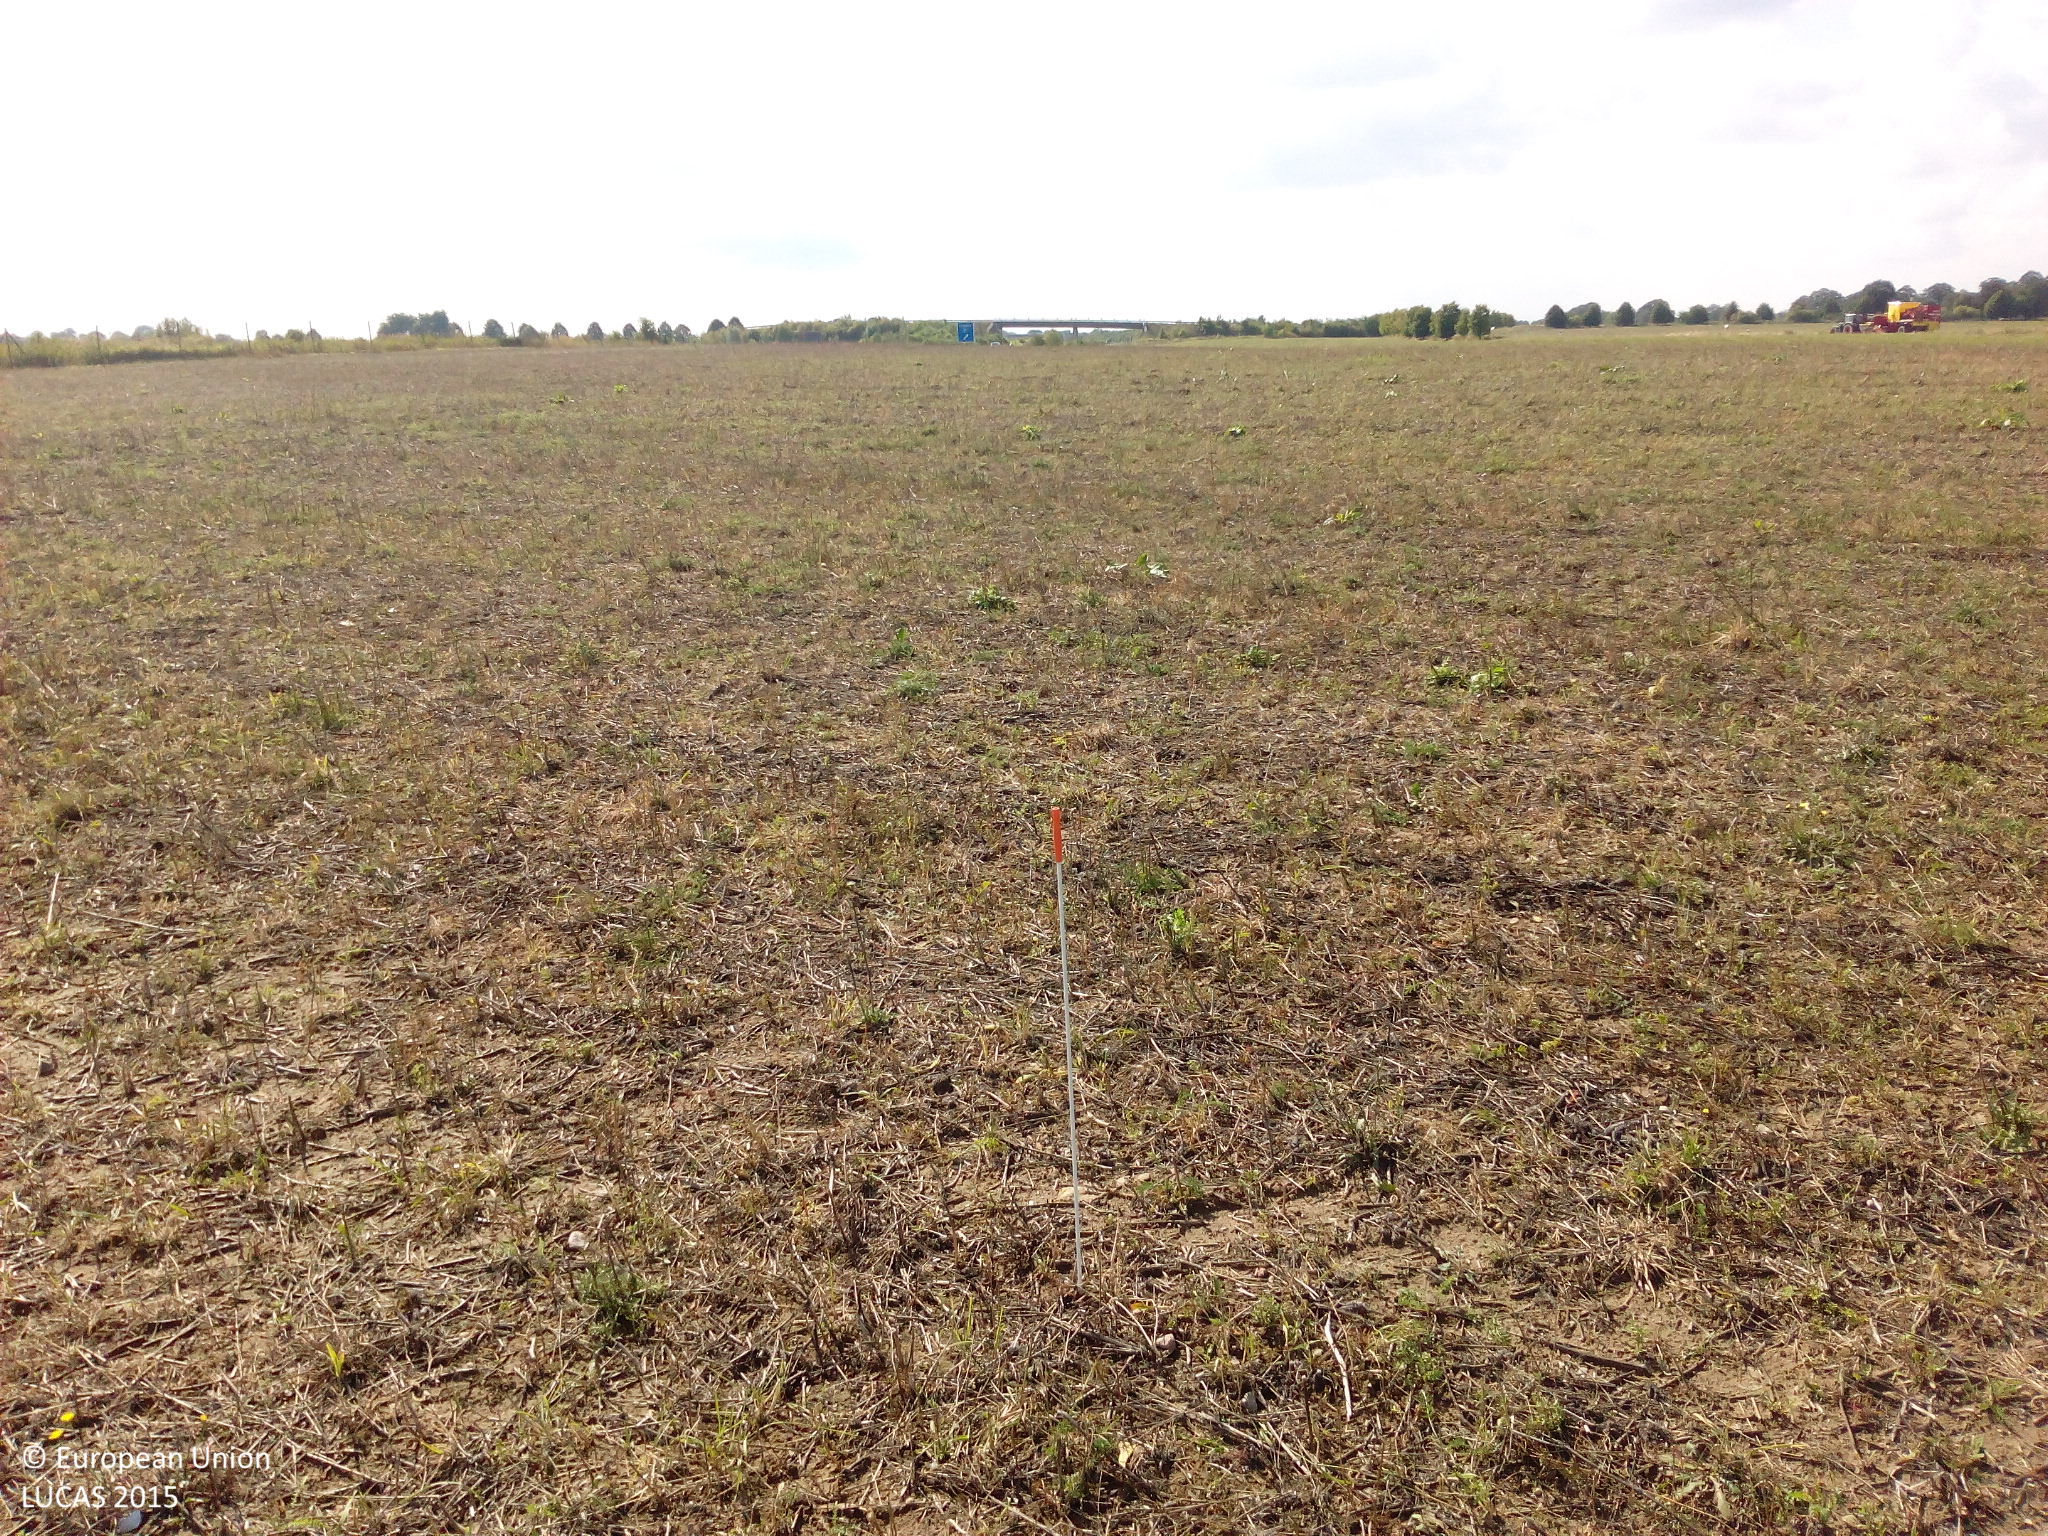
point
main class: Grassland
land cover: Spontaneously vegetated surfaces
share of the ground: 10 - 25 %
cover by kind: unconsolidated bare surface 60 %, herbaceous plants 40 %
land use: Agriculture (excluding fallow land and kitchen gardens)
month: August
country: DE
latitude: 54.0565
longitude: 12.6419
